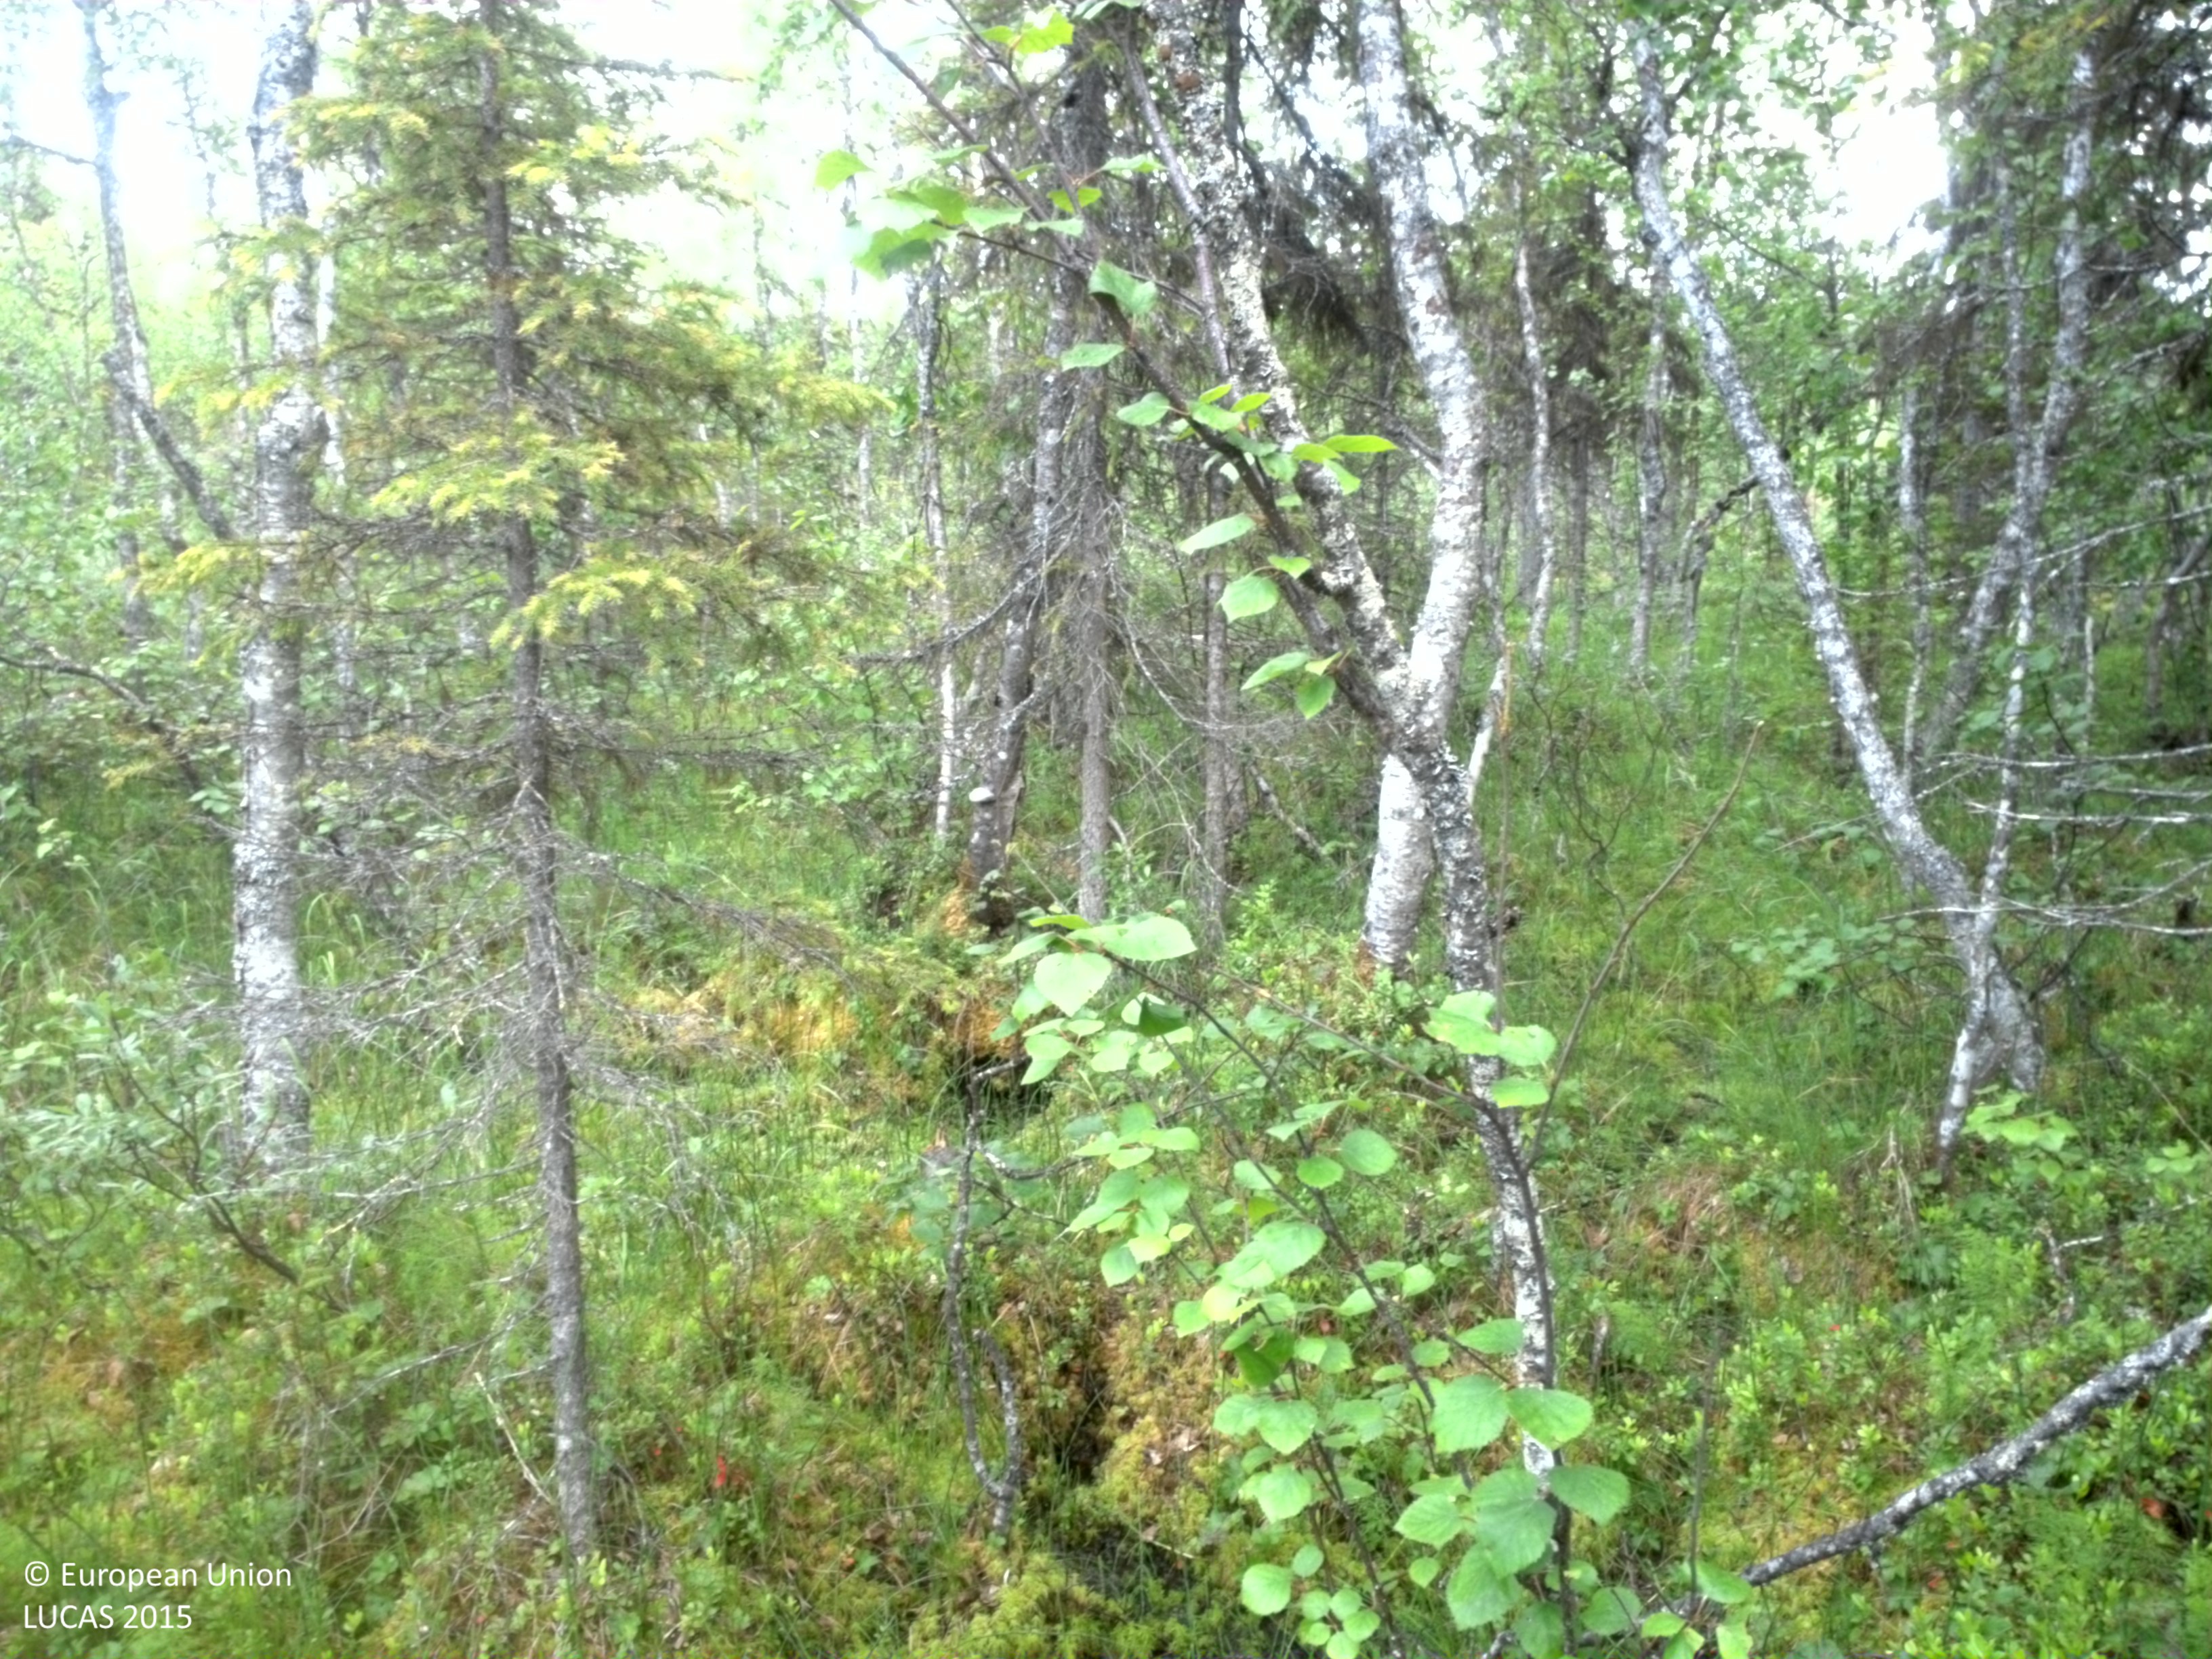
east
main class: Woodland
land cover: Spruce dominated mixed woodland
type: mire and swamp forests
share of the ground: 25 - 50 %
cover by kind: shrubs 45 %, coniferous forest trees 25 %, broadleaved forest trees 15 %, lichens and mosses 10 %, herbaceous plants 5 %
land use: Semi-natural and natural areas not in use
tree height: > 5 m
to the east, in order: Spruce dominated mixed woodland; Pine dominated mixed woodland; Pine dominated coniferous woodland; Broadleaved woodland; Tracks; Grass margins; Broadleaved woodland; Spruce dominated coniferous woodland
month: July
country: SE
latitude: 66.4246
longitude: 19.5657
